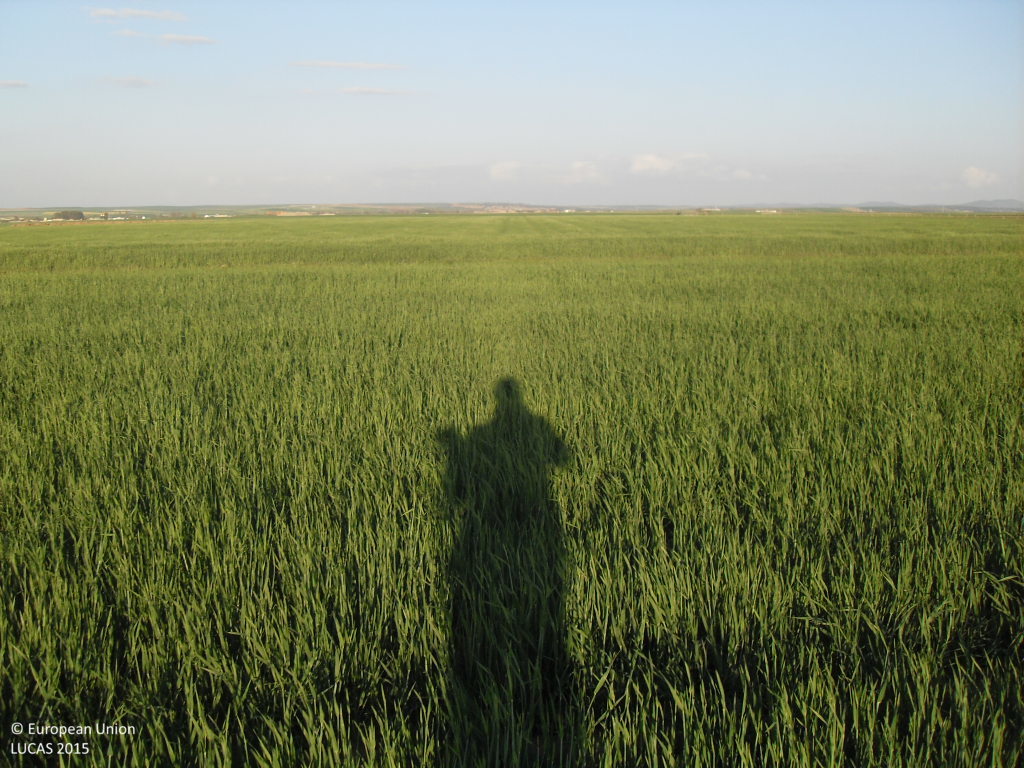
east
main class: Cropland
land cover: Barley
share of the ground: > 75 %
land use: Agriculture (excluding fallow land and kitchen gardens)
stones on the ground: < 10 %
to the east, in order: Barley; Grass margins; Tracks; Grass margins; Barley
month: May
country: ES
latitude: 40.8648
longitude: -5.2664
